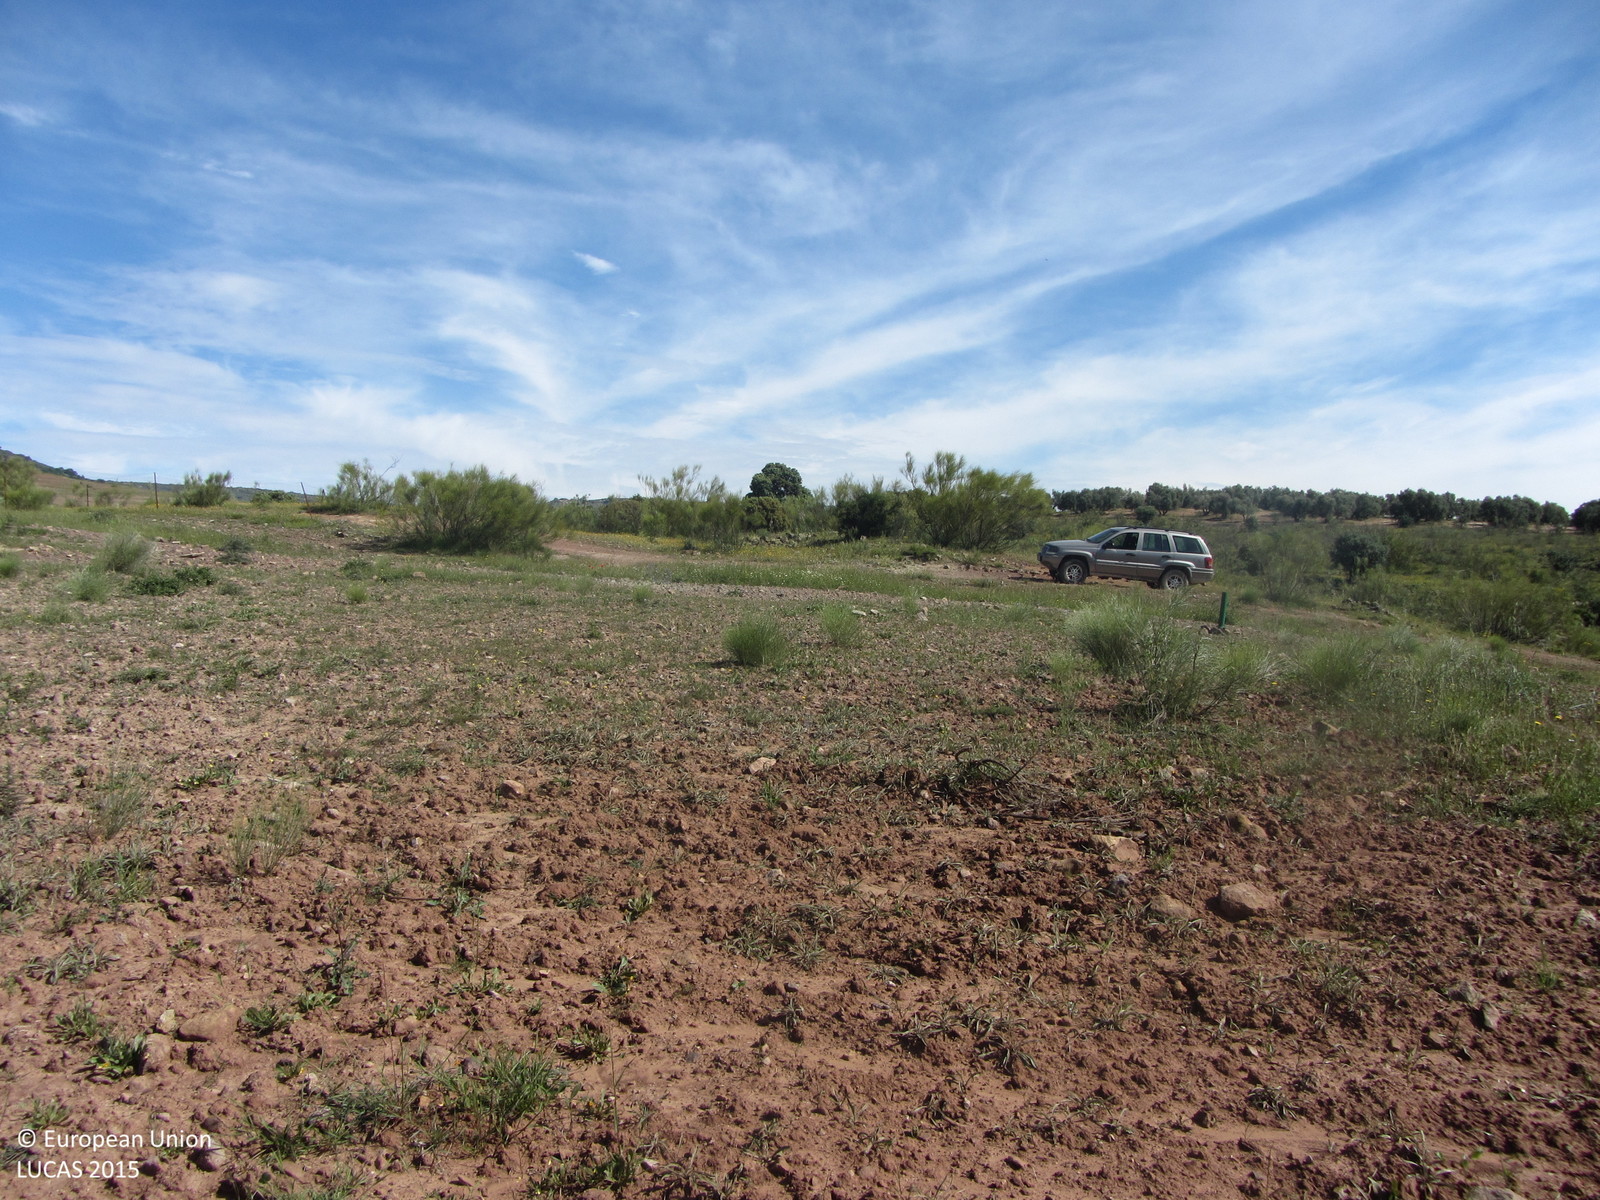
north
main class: Grassland
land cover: Spontaneously vegetated surfaces
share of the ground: 25 - 50 %
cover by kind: consolidated bare surface 65 %, herbaceous plants 35 %
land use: Semi-natural and natural areas not in use
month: May
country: ES
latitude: 38.2722
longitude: -3.0658
